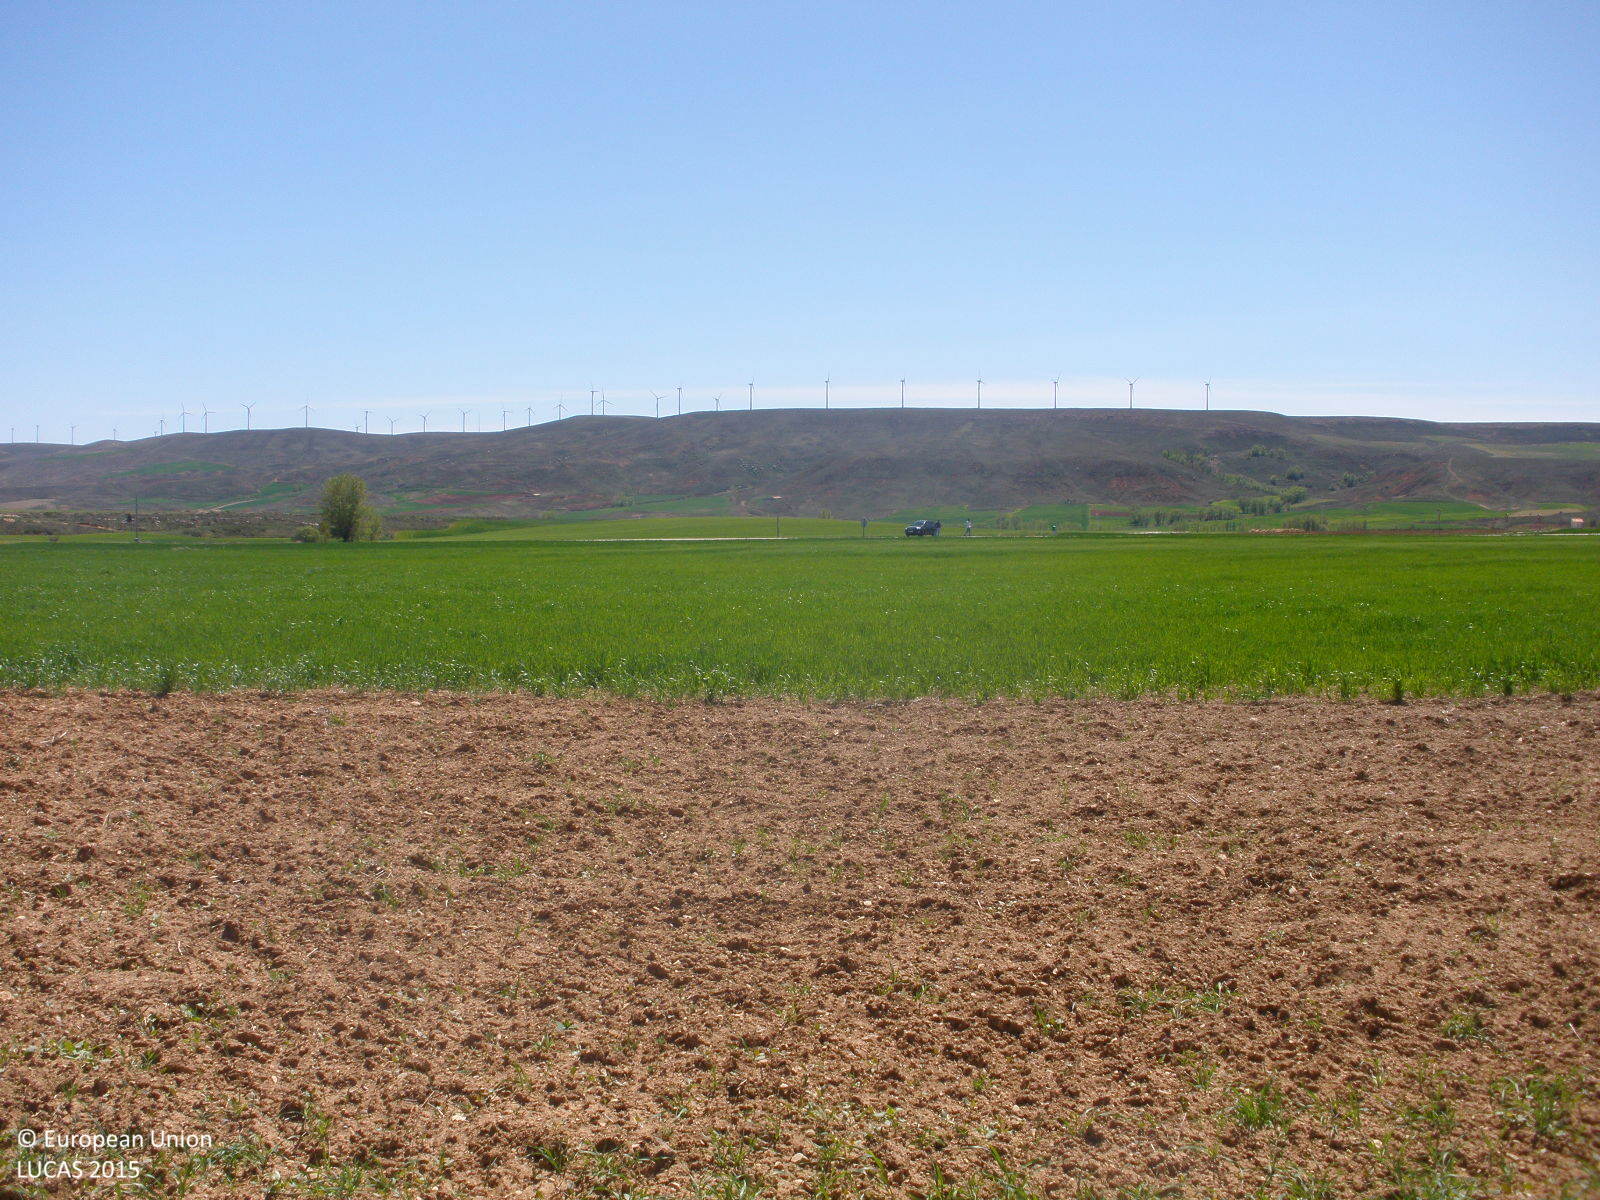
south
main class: Grassland
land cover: Spontaneously vegetated surfaces
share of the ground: 25 - 50 %
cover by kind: herbaceous plants 50 %, unconsolidated bare surface 50 %
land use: Fallow land
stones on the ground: < 10 %
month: May
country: ES
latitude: 40.7219
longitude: -0.8452
